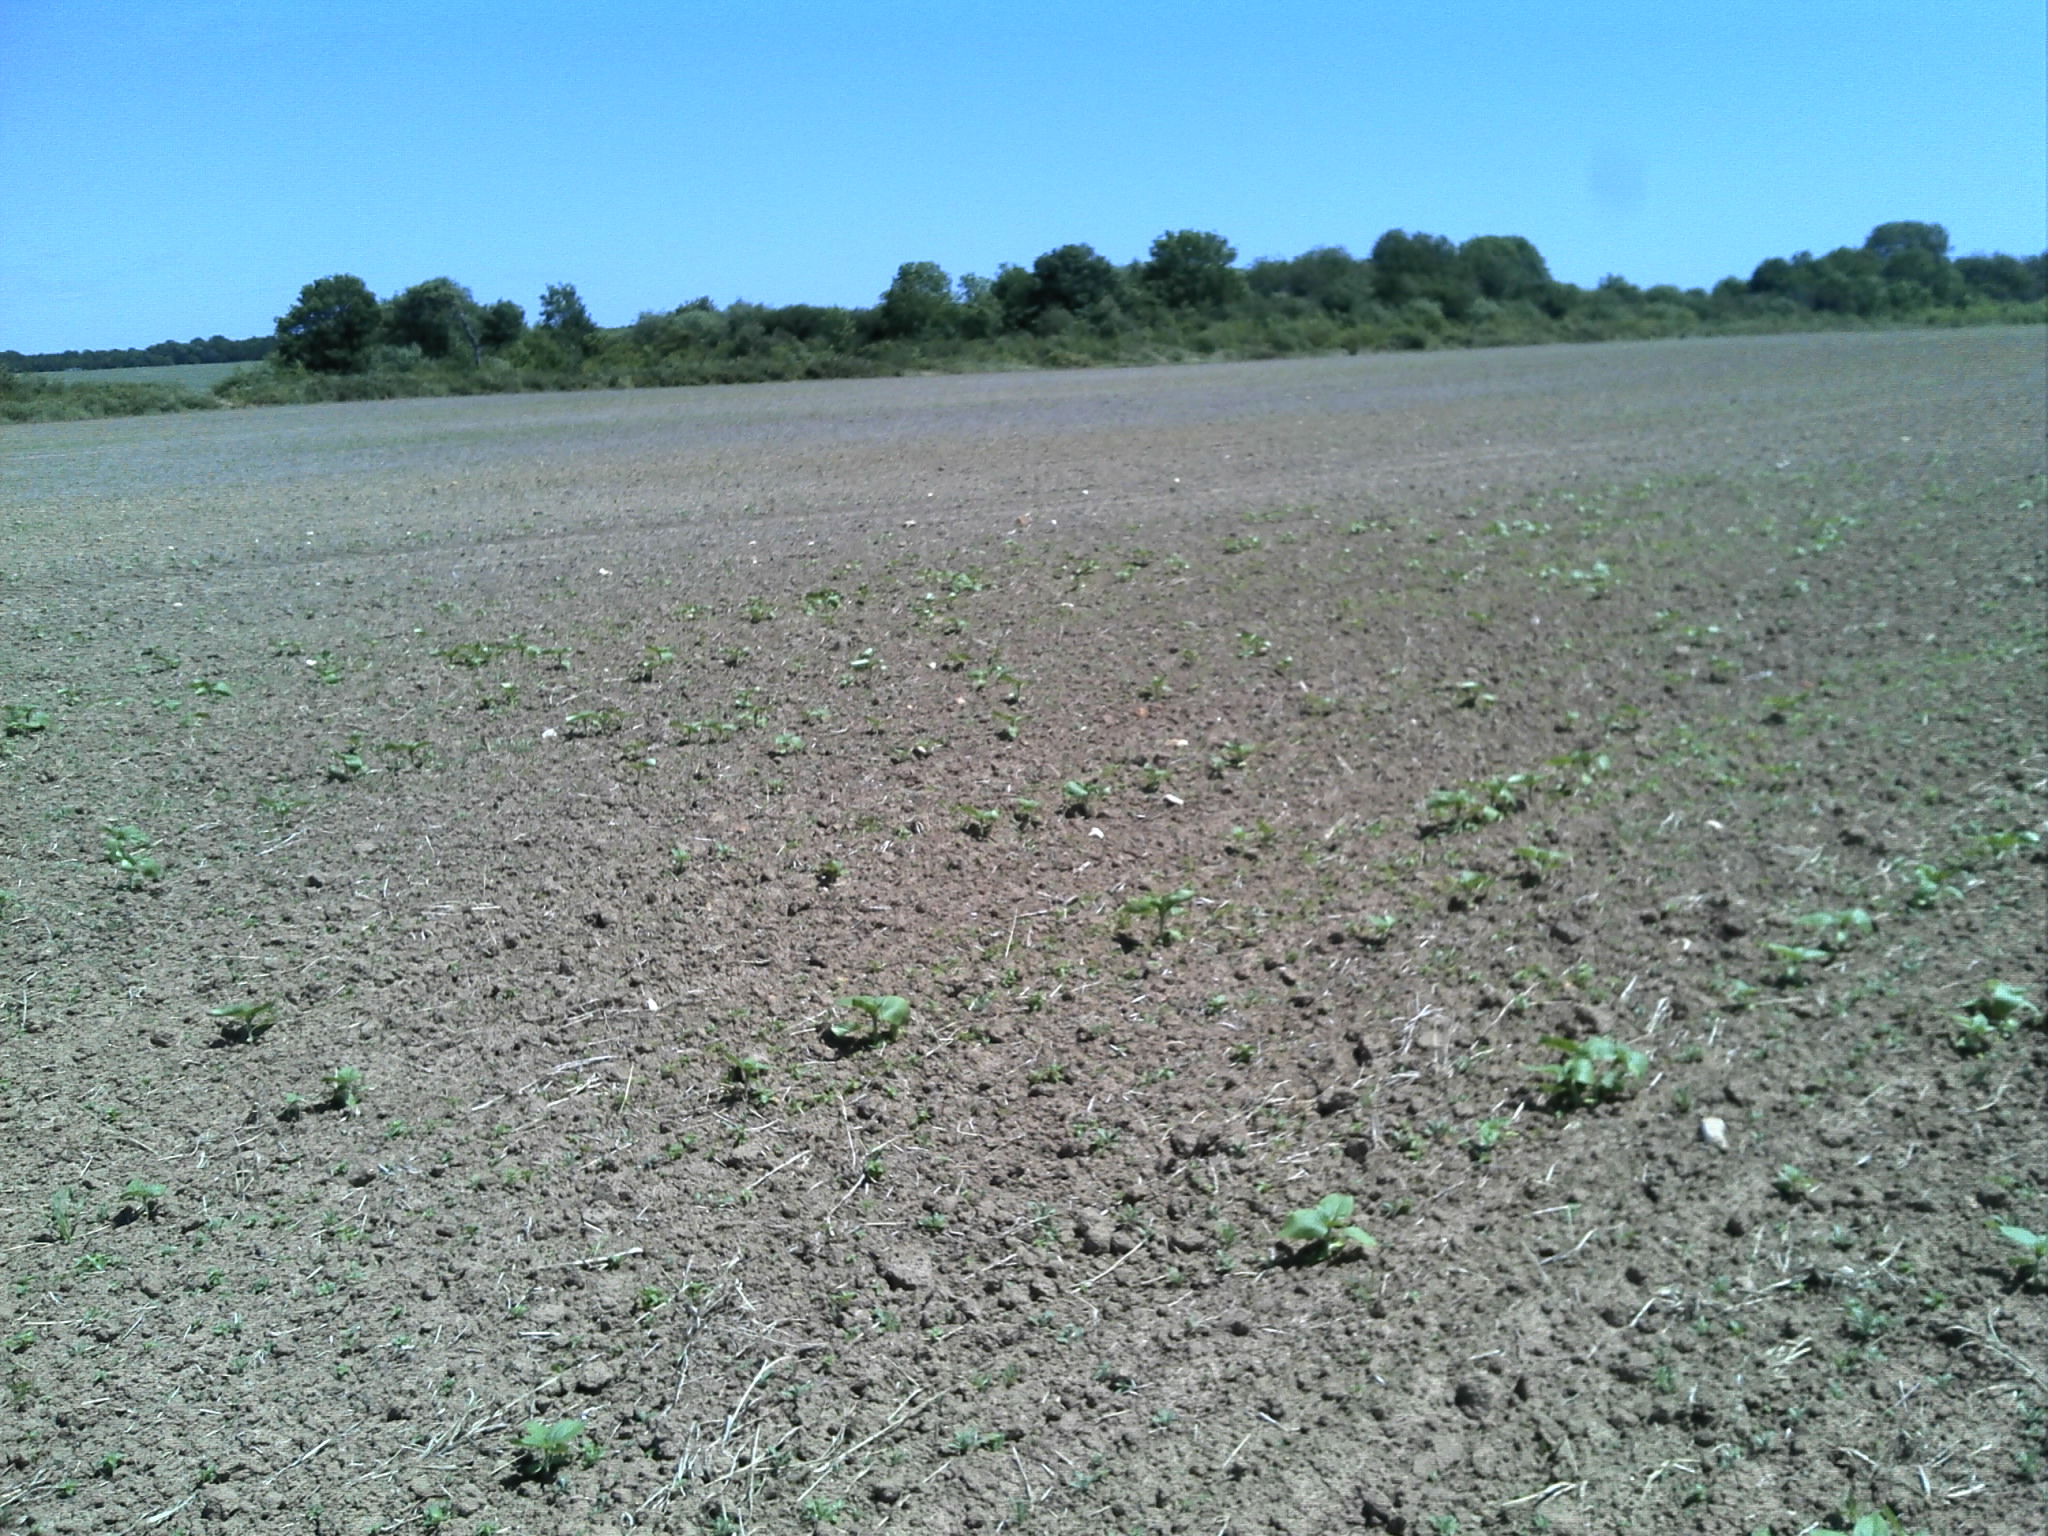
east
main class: Cropland
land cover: Sunflower
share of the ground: 10 - 25 %
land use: Agriculture (excluding fallow land and kitchen gardens)
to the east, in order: Sunflower; Shrubland without tree cover; Ditches and canals; Shrubland without tree cover; Inland fresh water bodies
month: June
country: FR
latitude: 46.5996
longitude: 1.1494
